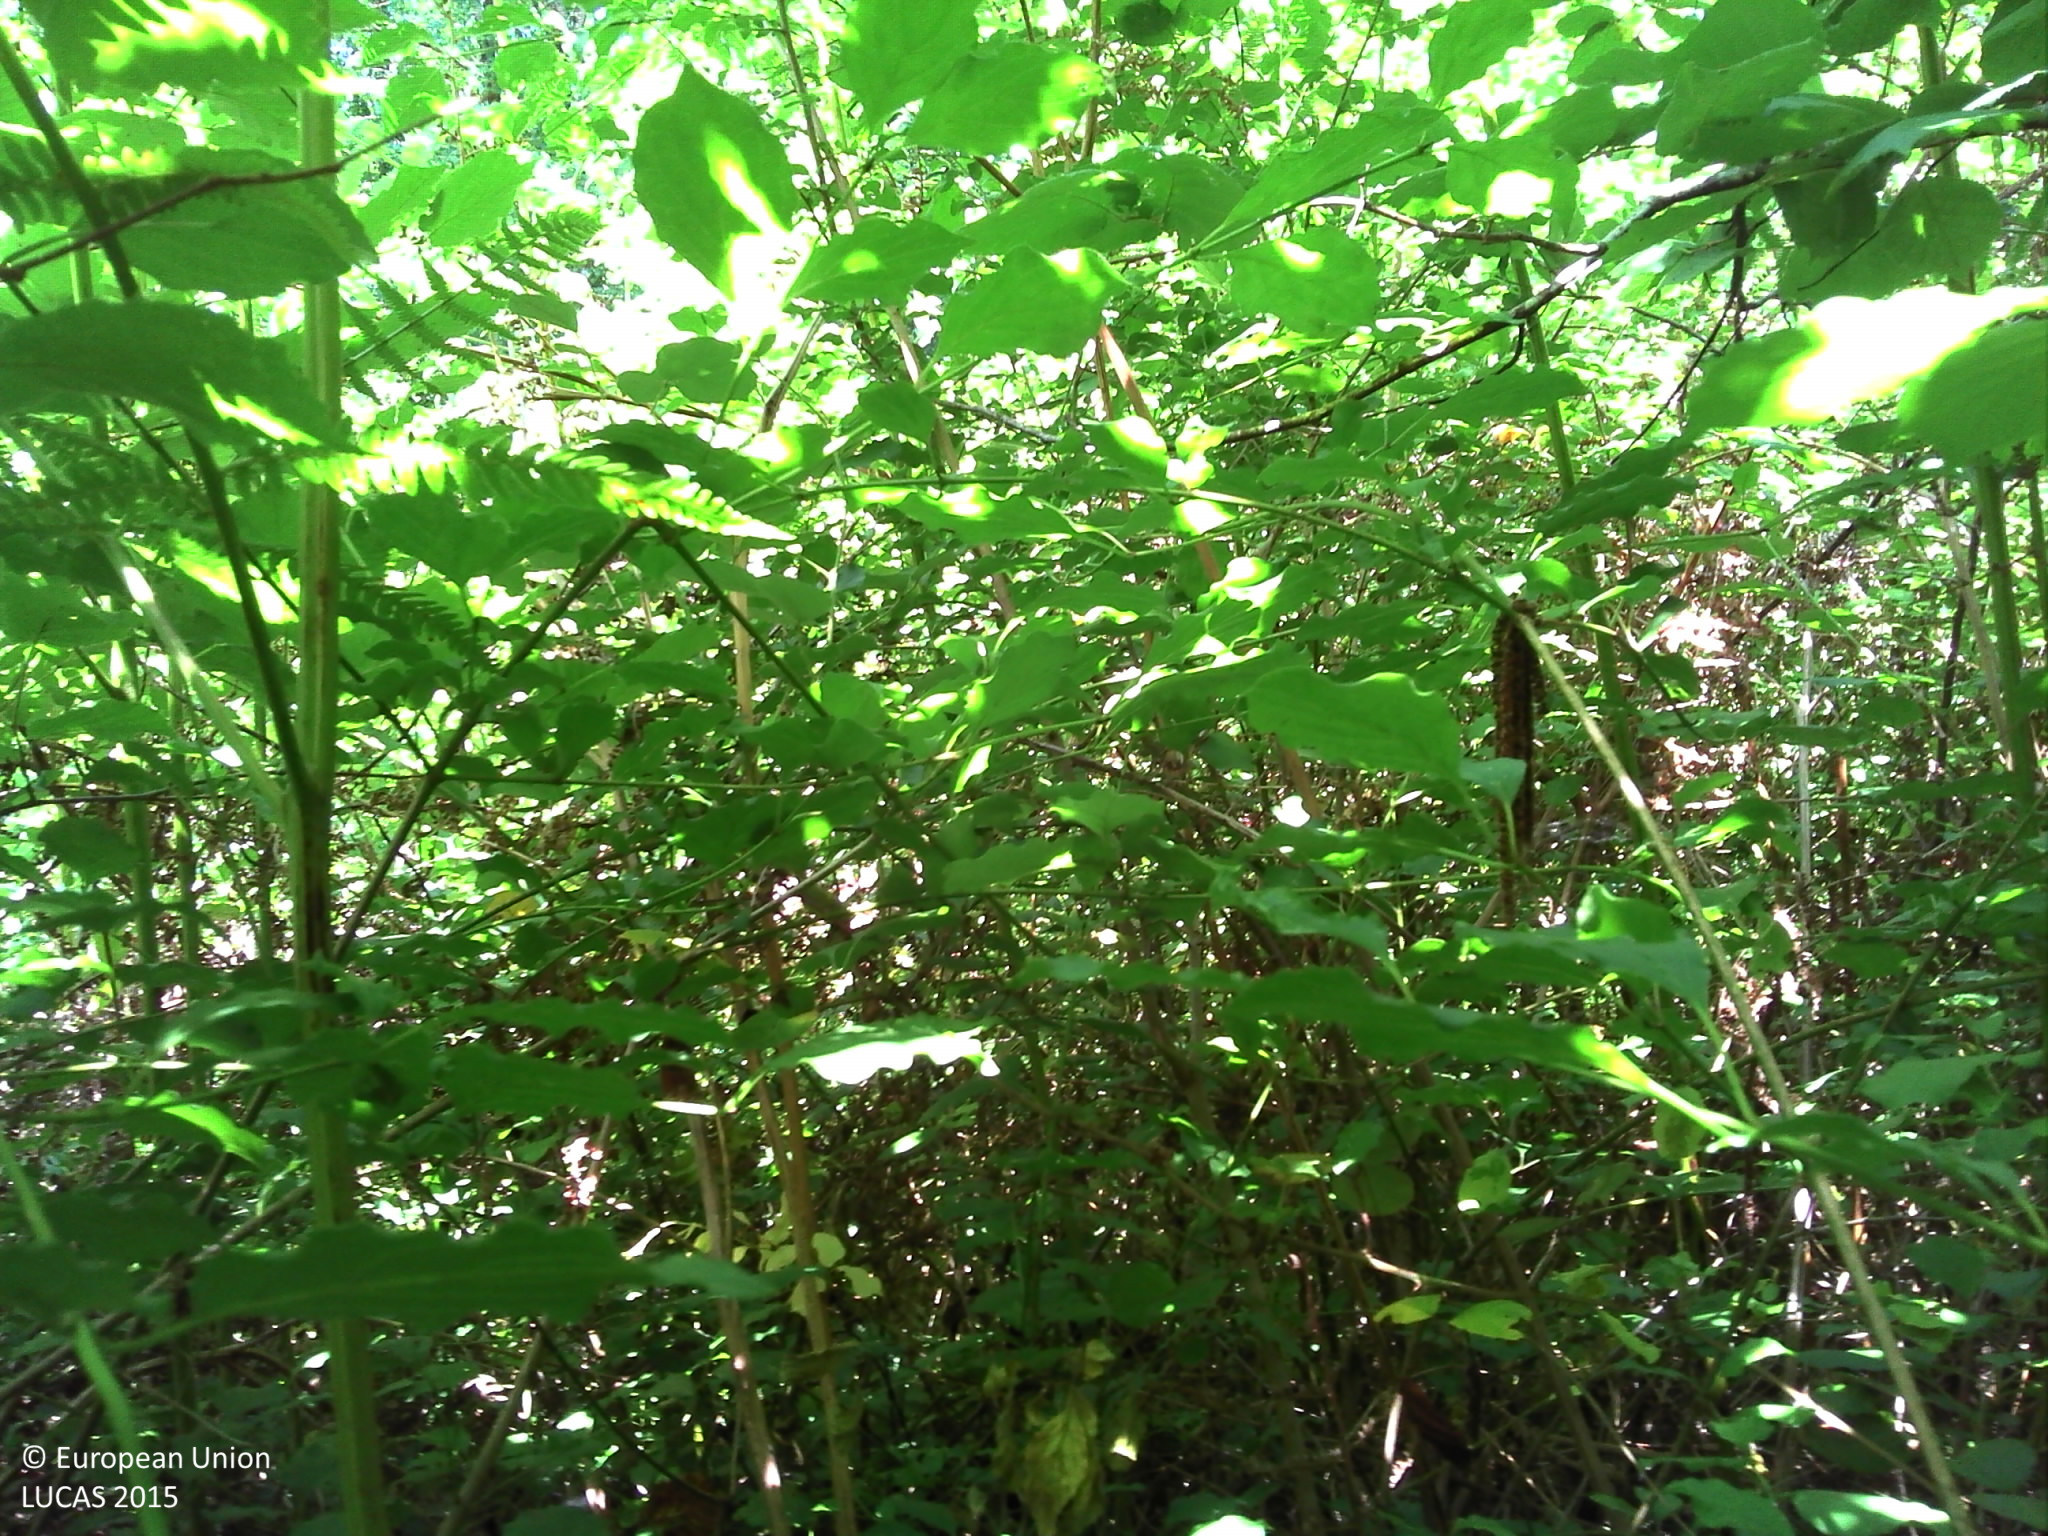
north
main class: Woodland
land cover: Broadleaved woodland
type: mesophytic deciduous forest
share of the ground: > 75 %
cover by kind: broadleaved forest trees 80 %, herbaceous plants 15 %, shrubs 5 %
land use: Forestry
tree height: > 5 m
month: June
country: FR
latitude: 45.6085
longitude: 0.3817
